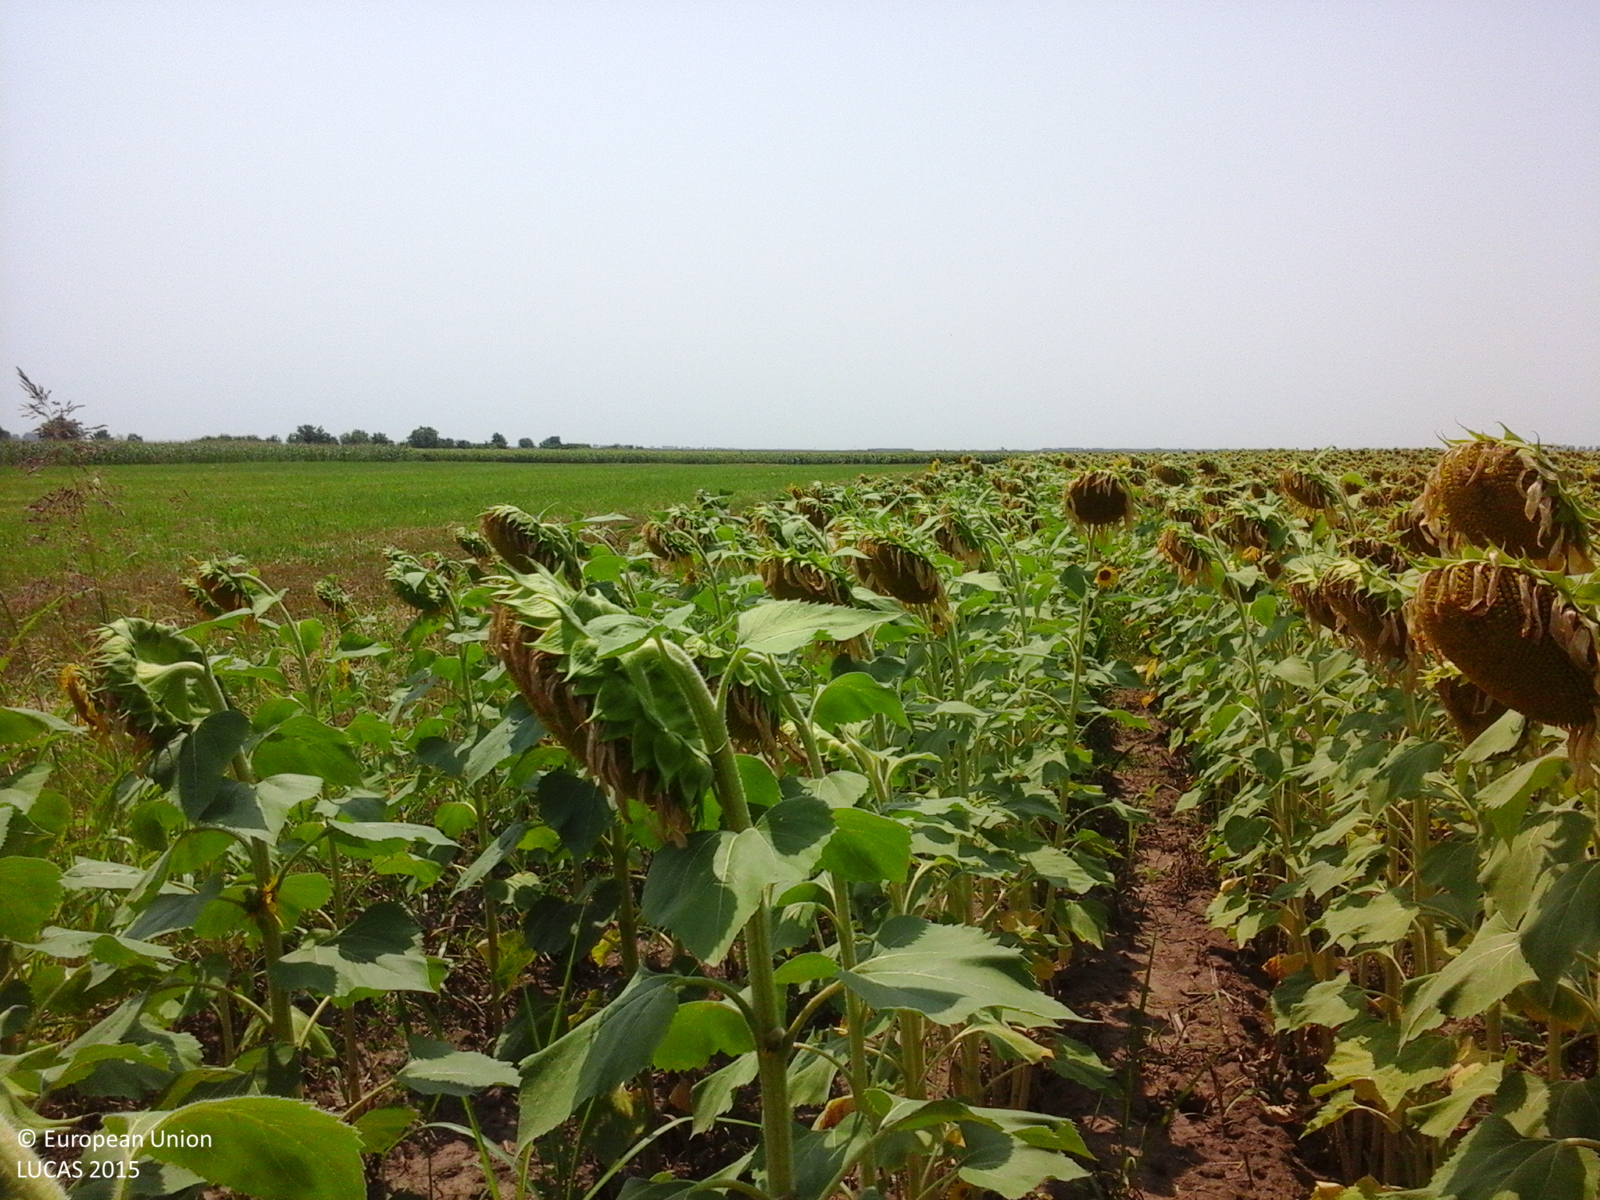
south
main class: Cropland
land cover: Sunflower
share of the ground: > 75 %
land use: Agriculture (excluding fallow land and kitchen gardens)
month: July
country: RO
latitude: 44.6602
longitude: 26.5774
